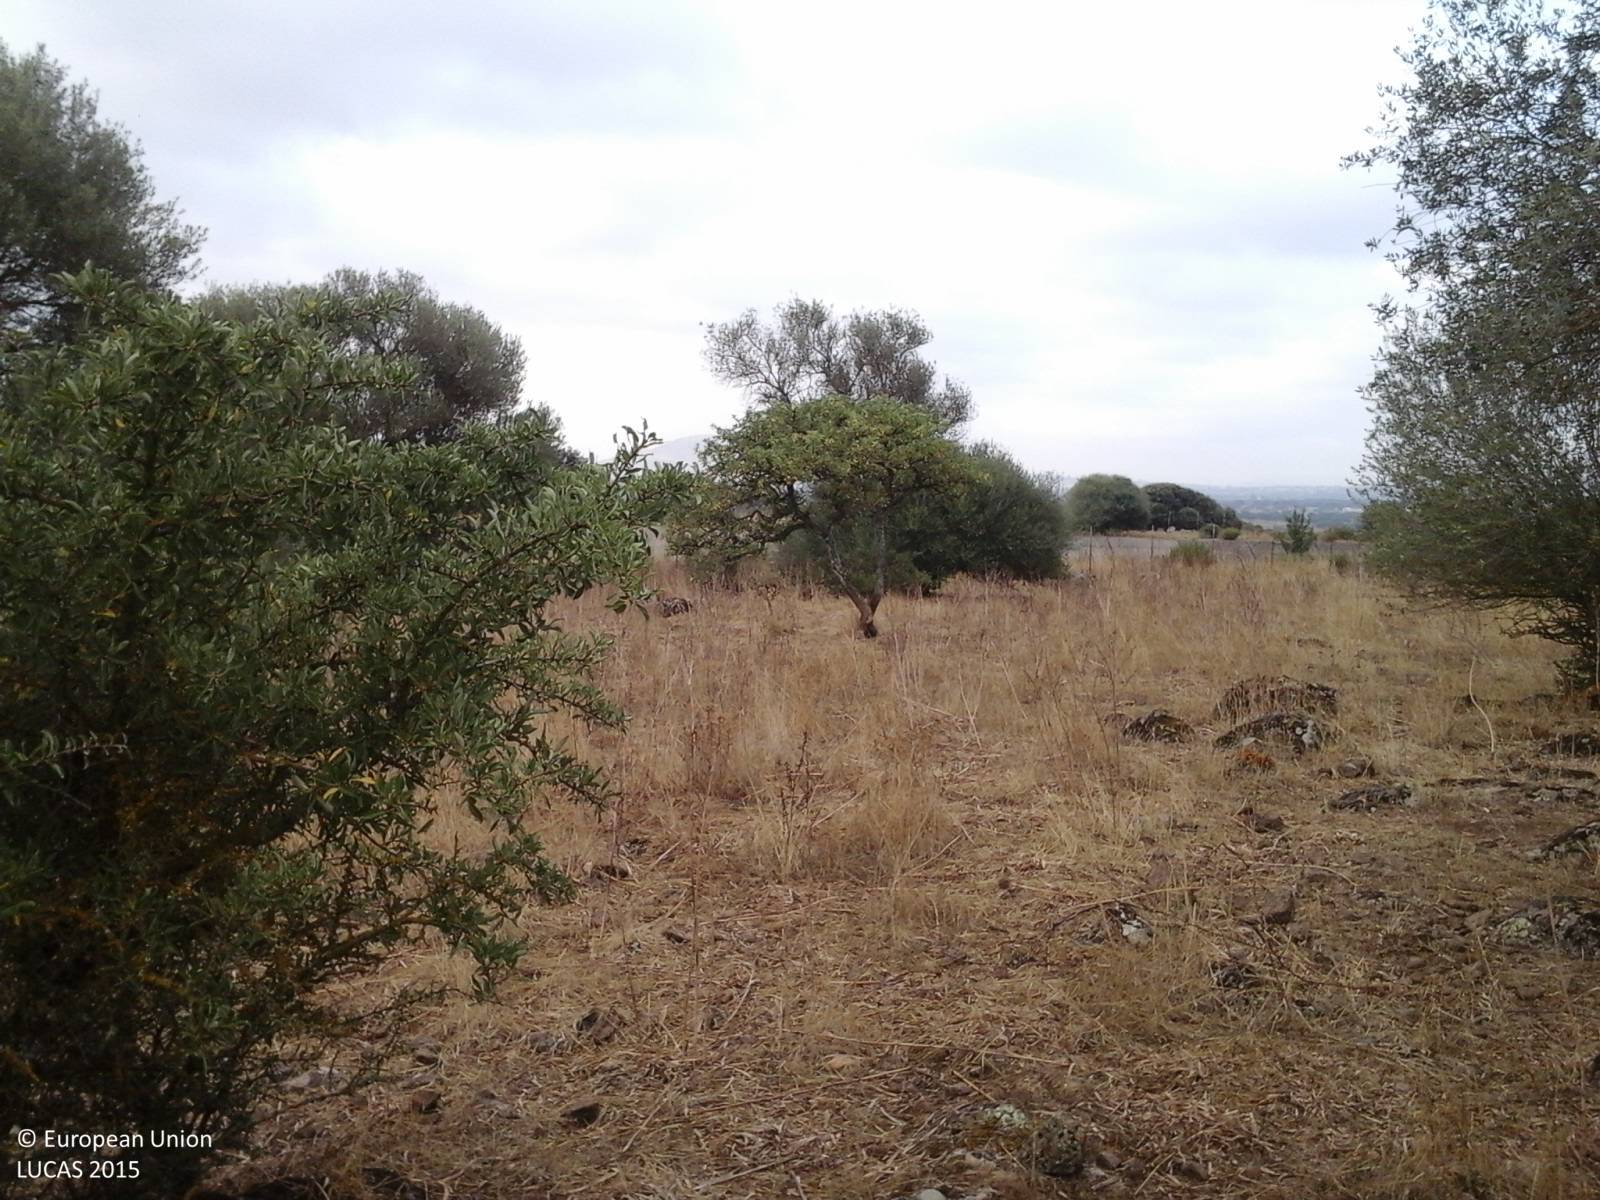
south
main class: Cropland
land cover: Olive groves
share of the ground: 10 - 25 %
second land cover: Spontaneously vegetated surfaces
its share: > 75 %
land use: Agriculture (excluding fallow land and kitchen gardens)
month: July
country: IT
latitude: 40.6405
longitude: 8.8351
